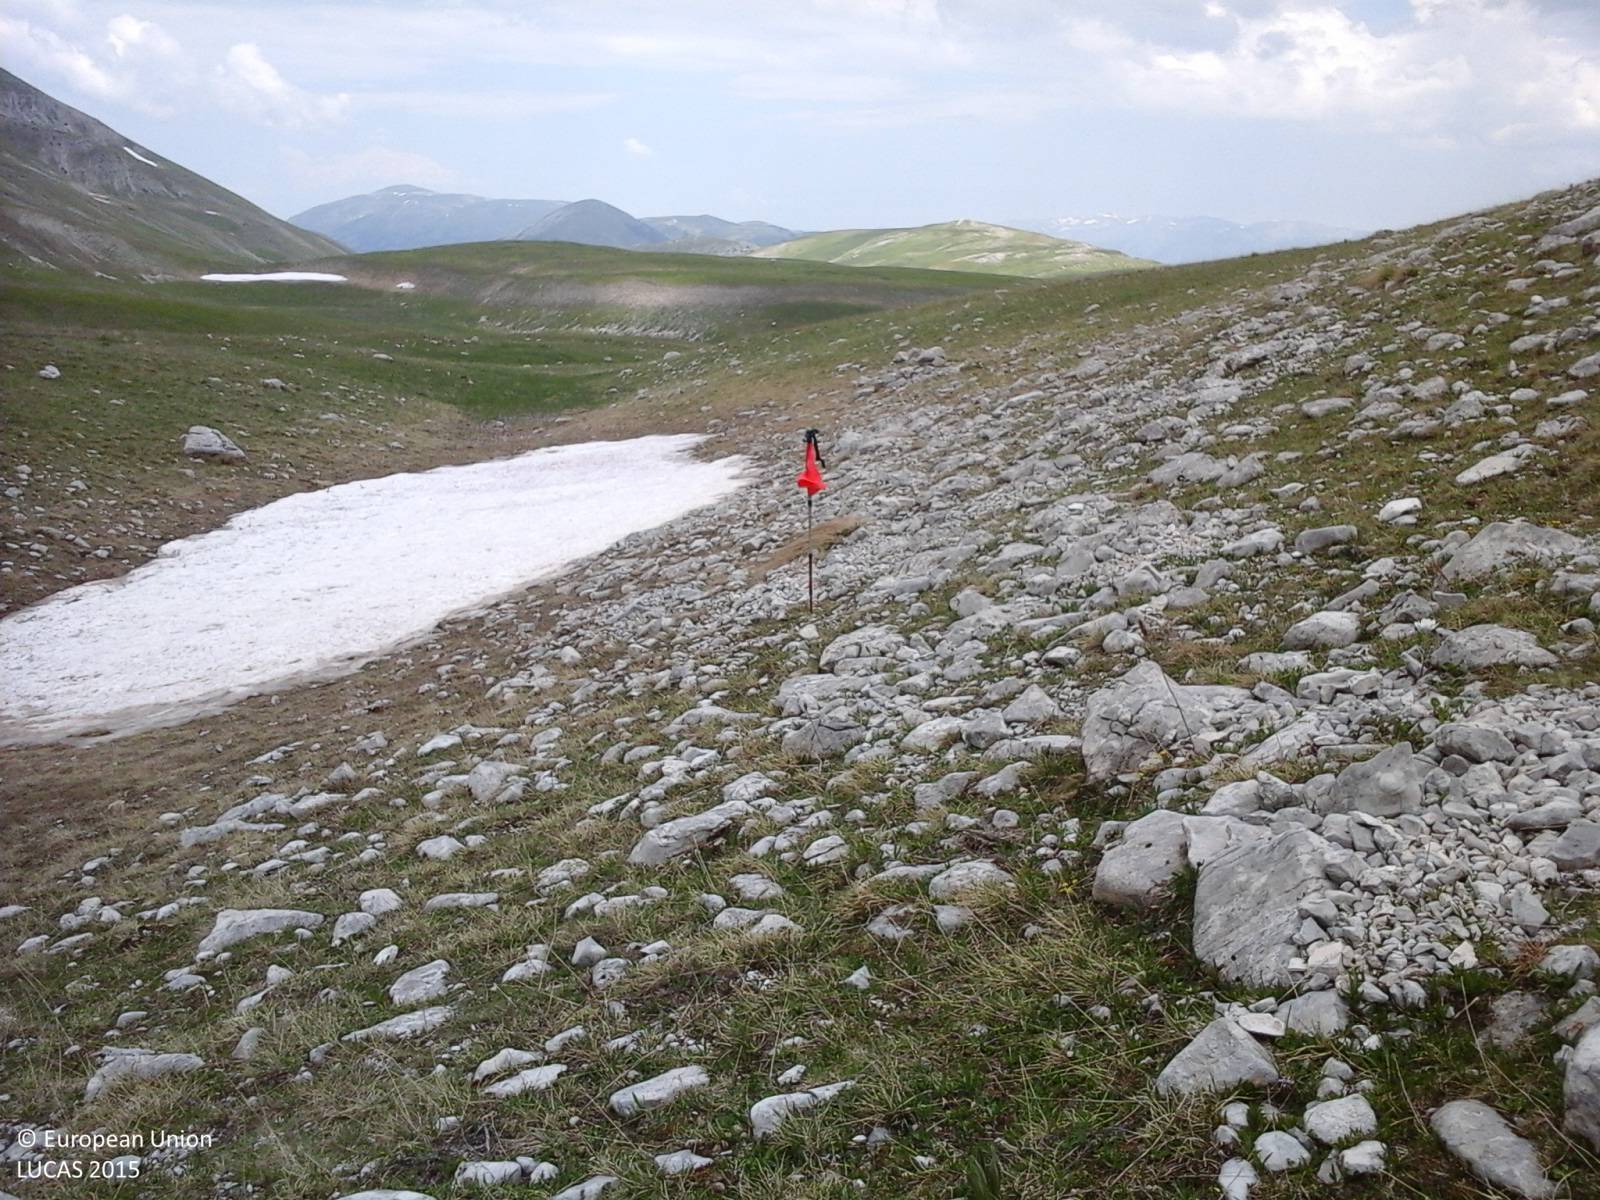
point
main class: Grassland
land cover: Grassland without tree/shrub cover
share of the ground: > 75 %
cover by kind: herbaceous plants 85 %, unconsolidated bare surface 10 %
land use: Agriculture (excluding fallow land and kitchen gardens)
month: June
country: IT
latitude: 41.8165
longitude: 13.9708
